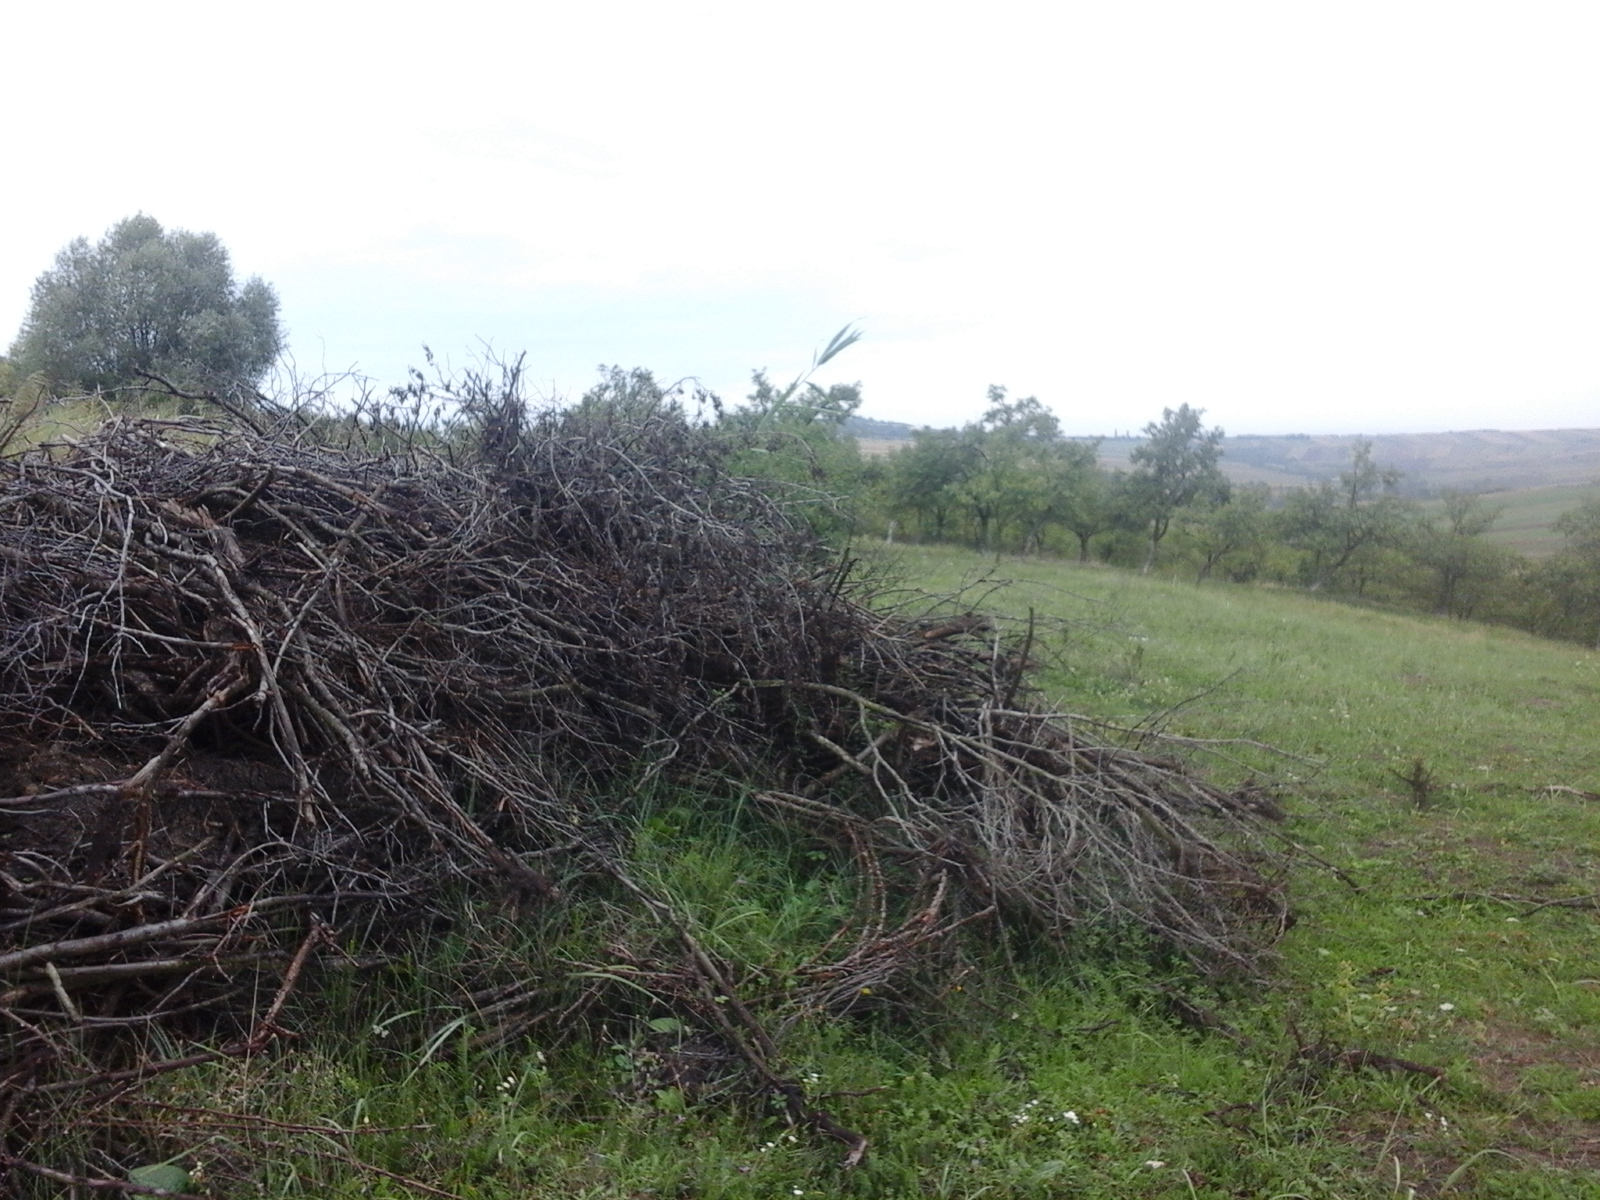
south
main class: Grassland
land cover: Grassland without tree/shrub cover
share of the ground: > 75 %
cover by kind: herbaceous plants 100 %
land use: Agriculture (excluding fallow land and kitchen gardens)
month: September
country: RO
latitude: 47.3137
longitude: 22.6117
